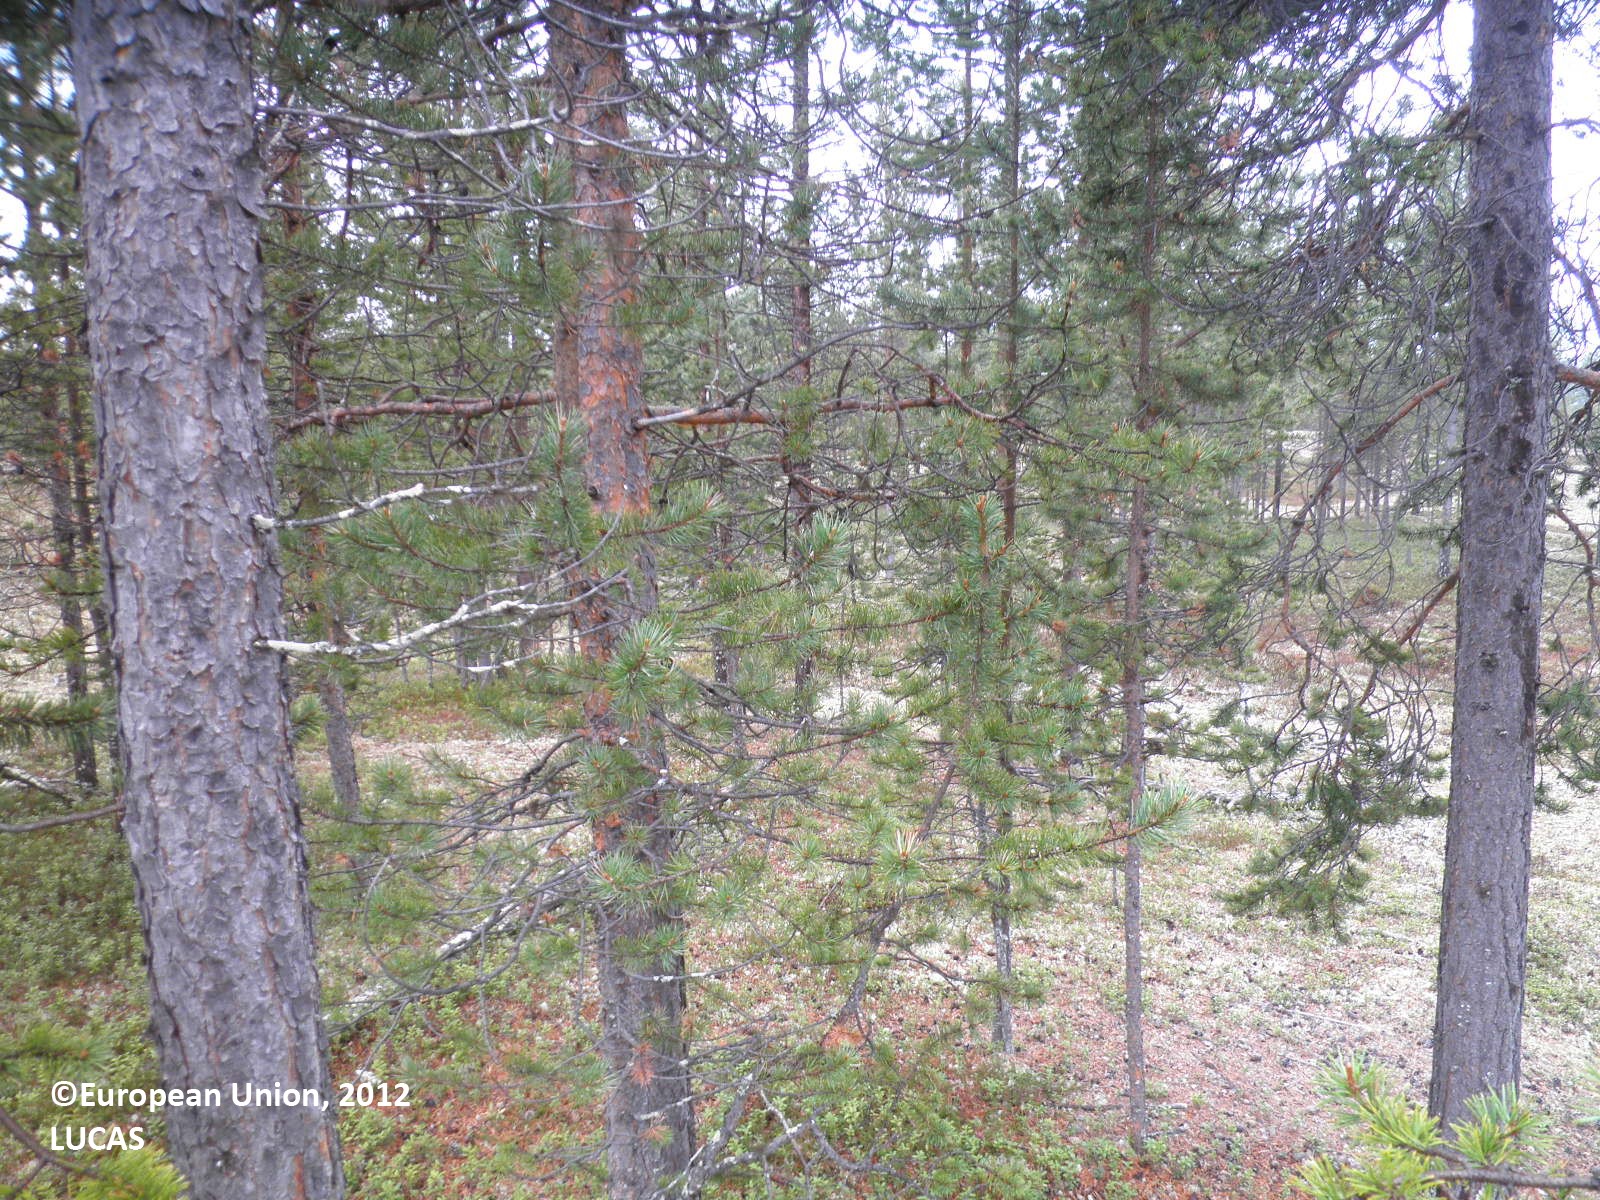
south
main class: Woodland
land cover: Pine dominated coniferous woodland
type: boreal forest
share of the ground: > 75 %
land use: Forestry
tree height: > 5 m
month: June
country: FI
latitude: 69.0768
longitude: 27.0441
